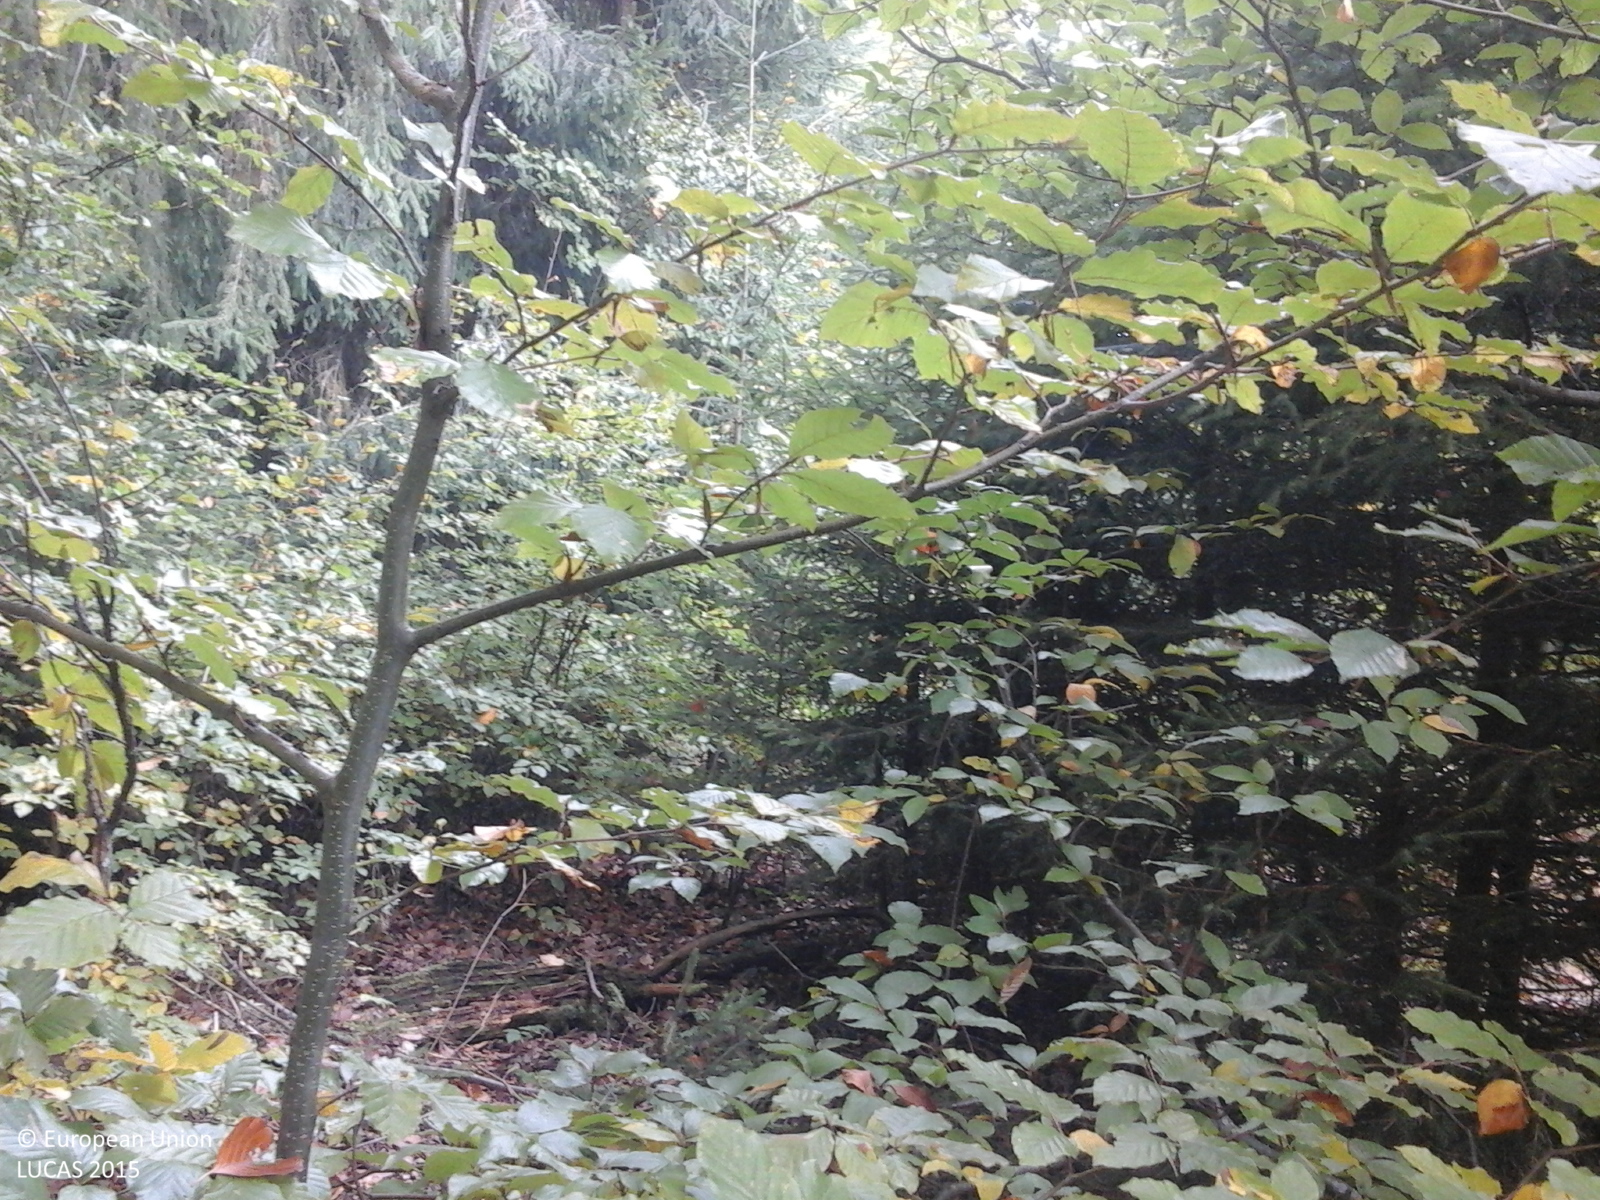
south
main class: Woodland
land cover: Other mixed woodland
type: alpine coniferous forest
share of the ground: > 75 %
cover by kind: coniferous forest trees 60 %, broadleaved forest trees 40 %
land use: Forestry
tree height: > 5 m
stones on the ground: 10 - 25 %
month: October
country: RO
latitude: 46.5507
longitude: 25.2455
